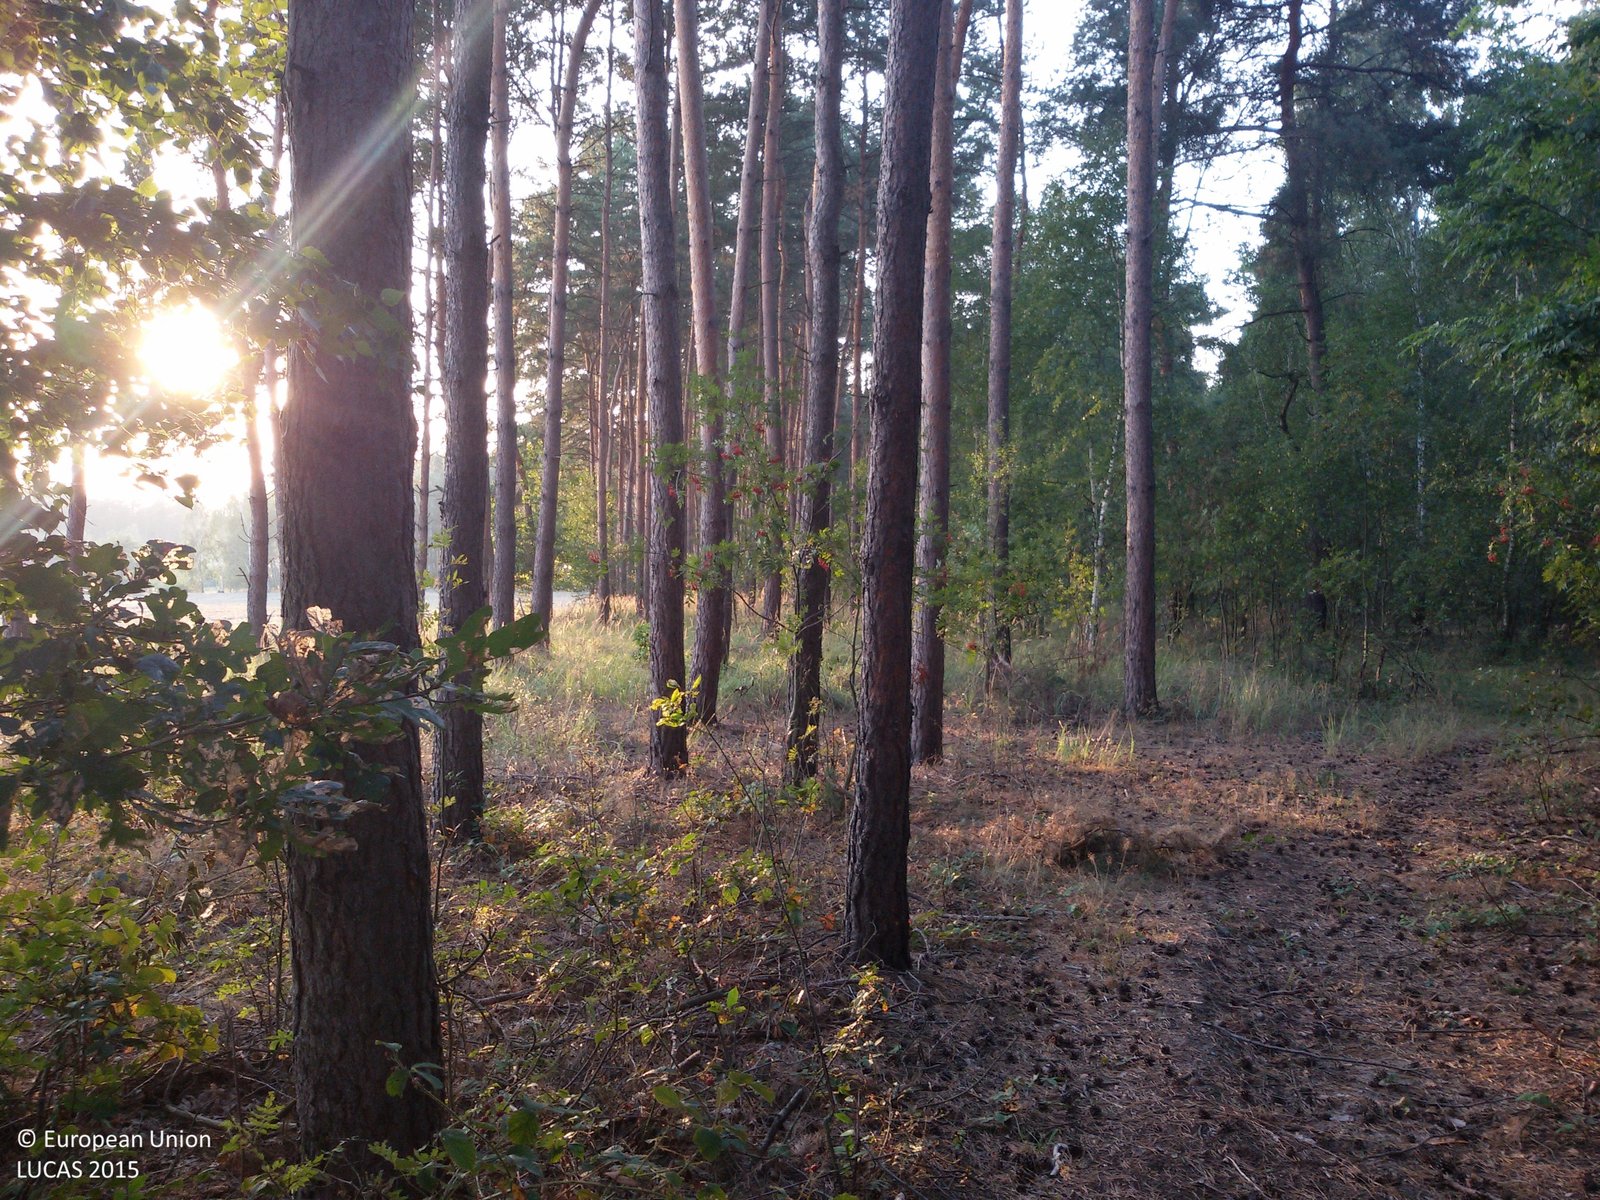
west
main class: Woodland
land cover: Pine dominated coniferous woodland
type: hemiboreal forest and nemoral coniferous forest and mixed broadleaved-coniferous forest
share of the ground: > 75 %
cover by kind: coniferous forest trees 60 %, broadleaved forest trees 20 %, herbaceous plants 10 %, unconsolidated bare surface 10 %
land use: Forestry
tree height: > 5 m
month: September
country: PL
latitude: 52.4145
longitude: 17.9989
